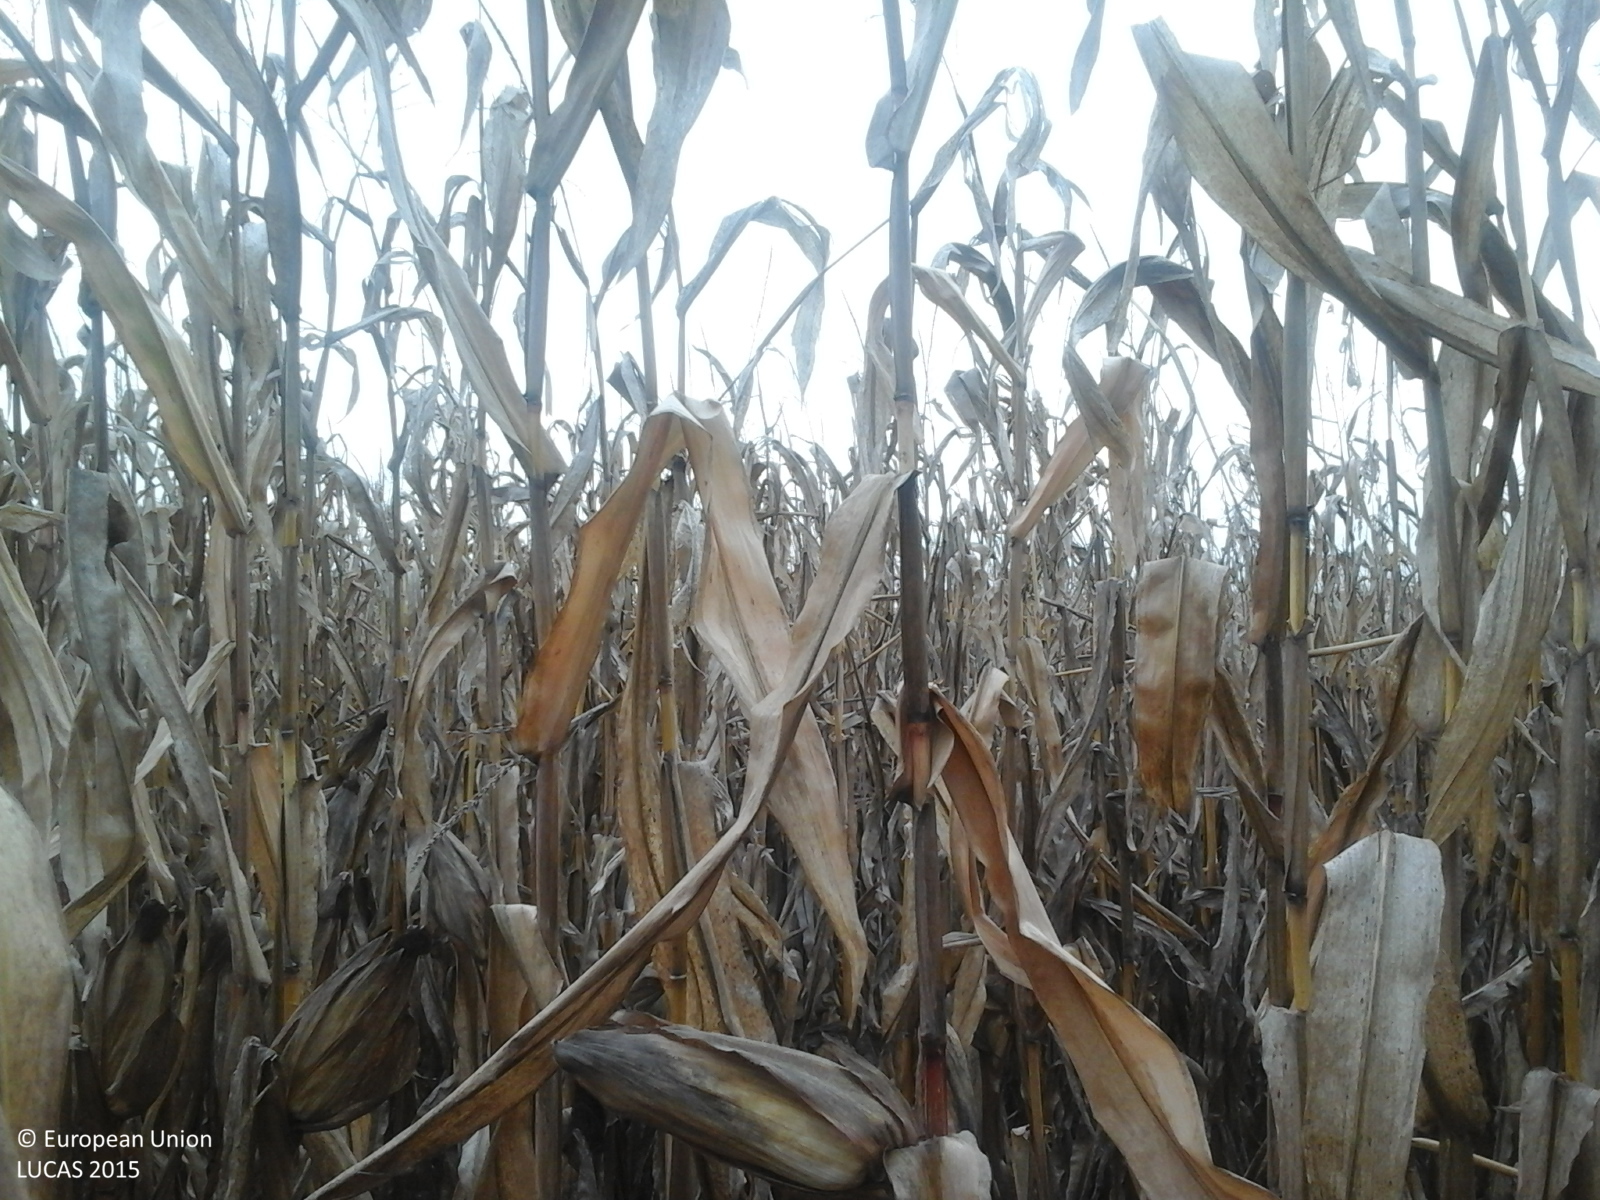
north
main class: Cropland
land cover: Maize
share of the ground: > 75 %
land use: Agriculture (excluding fallow land and kitchen gardens)
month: October
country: RO
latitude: 46.4496
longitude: 24.1256
